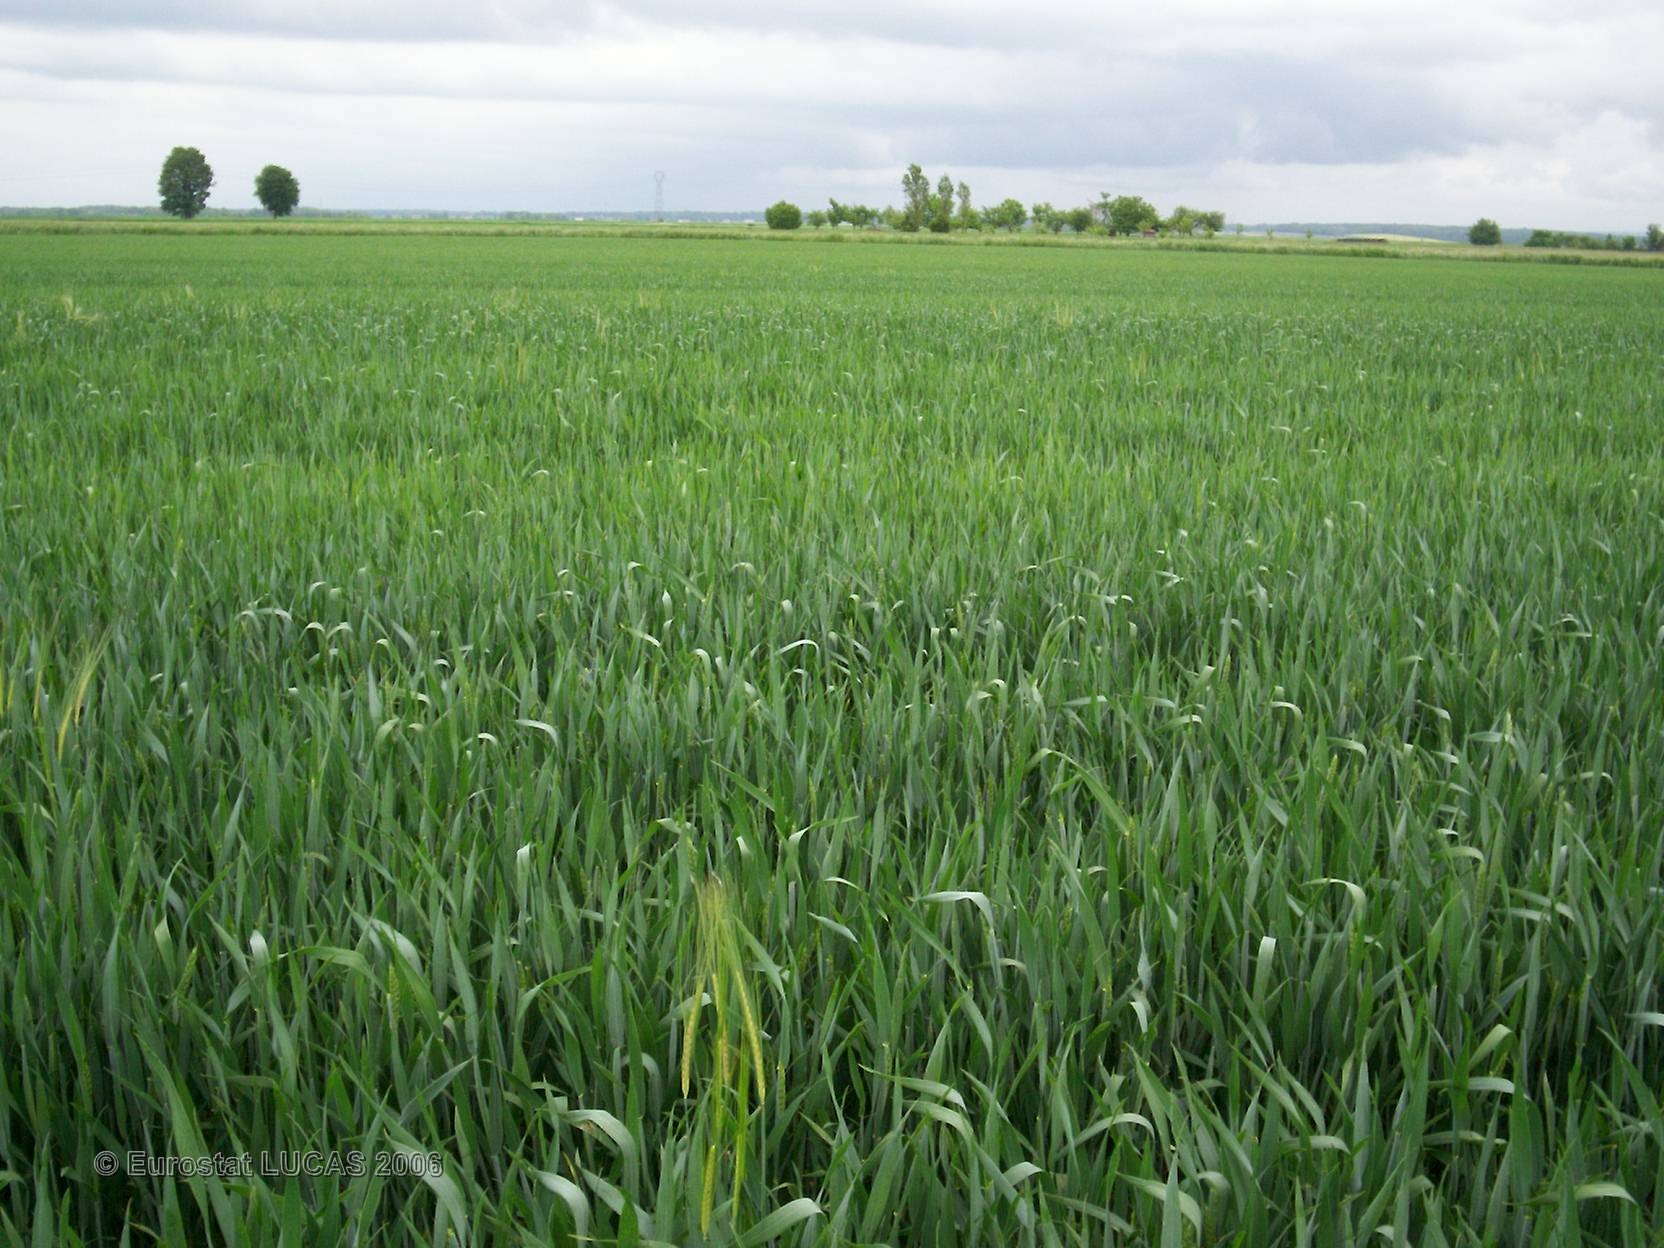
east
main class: Cropland
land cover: Common wheat
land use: Agriculture (excluding fallow land and kitchen gardens)
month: May
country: FR
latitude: 48.3584
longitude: 4.5316
